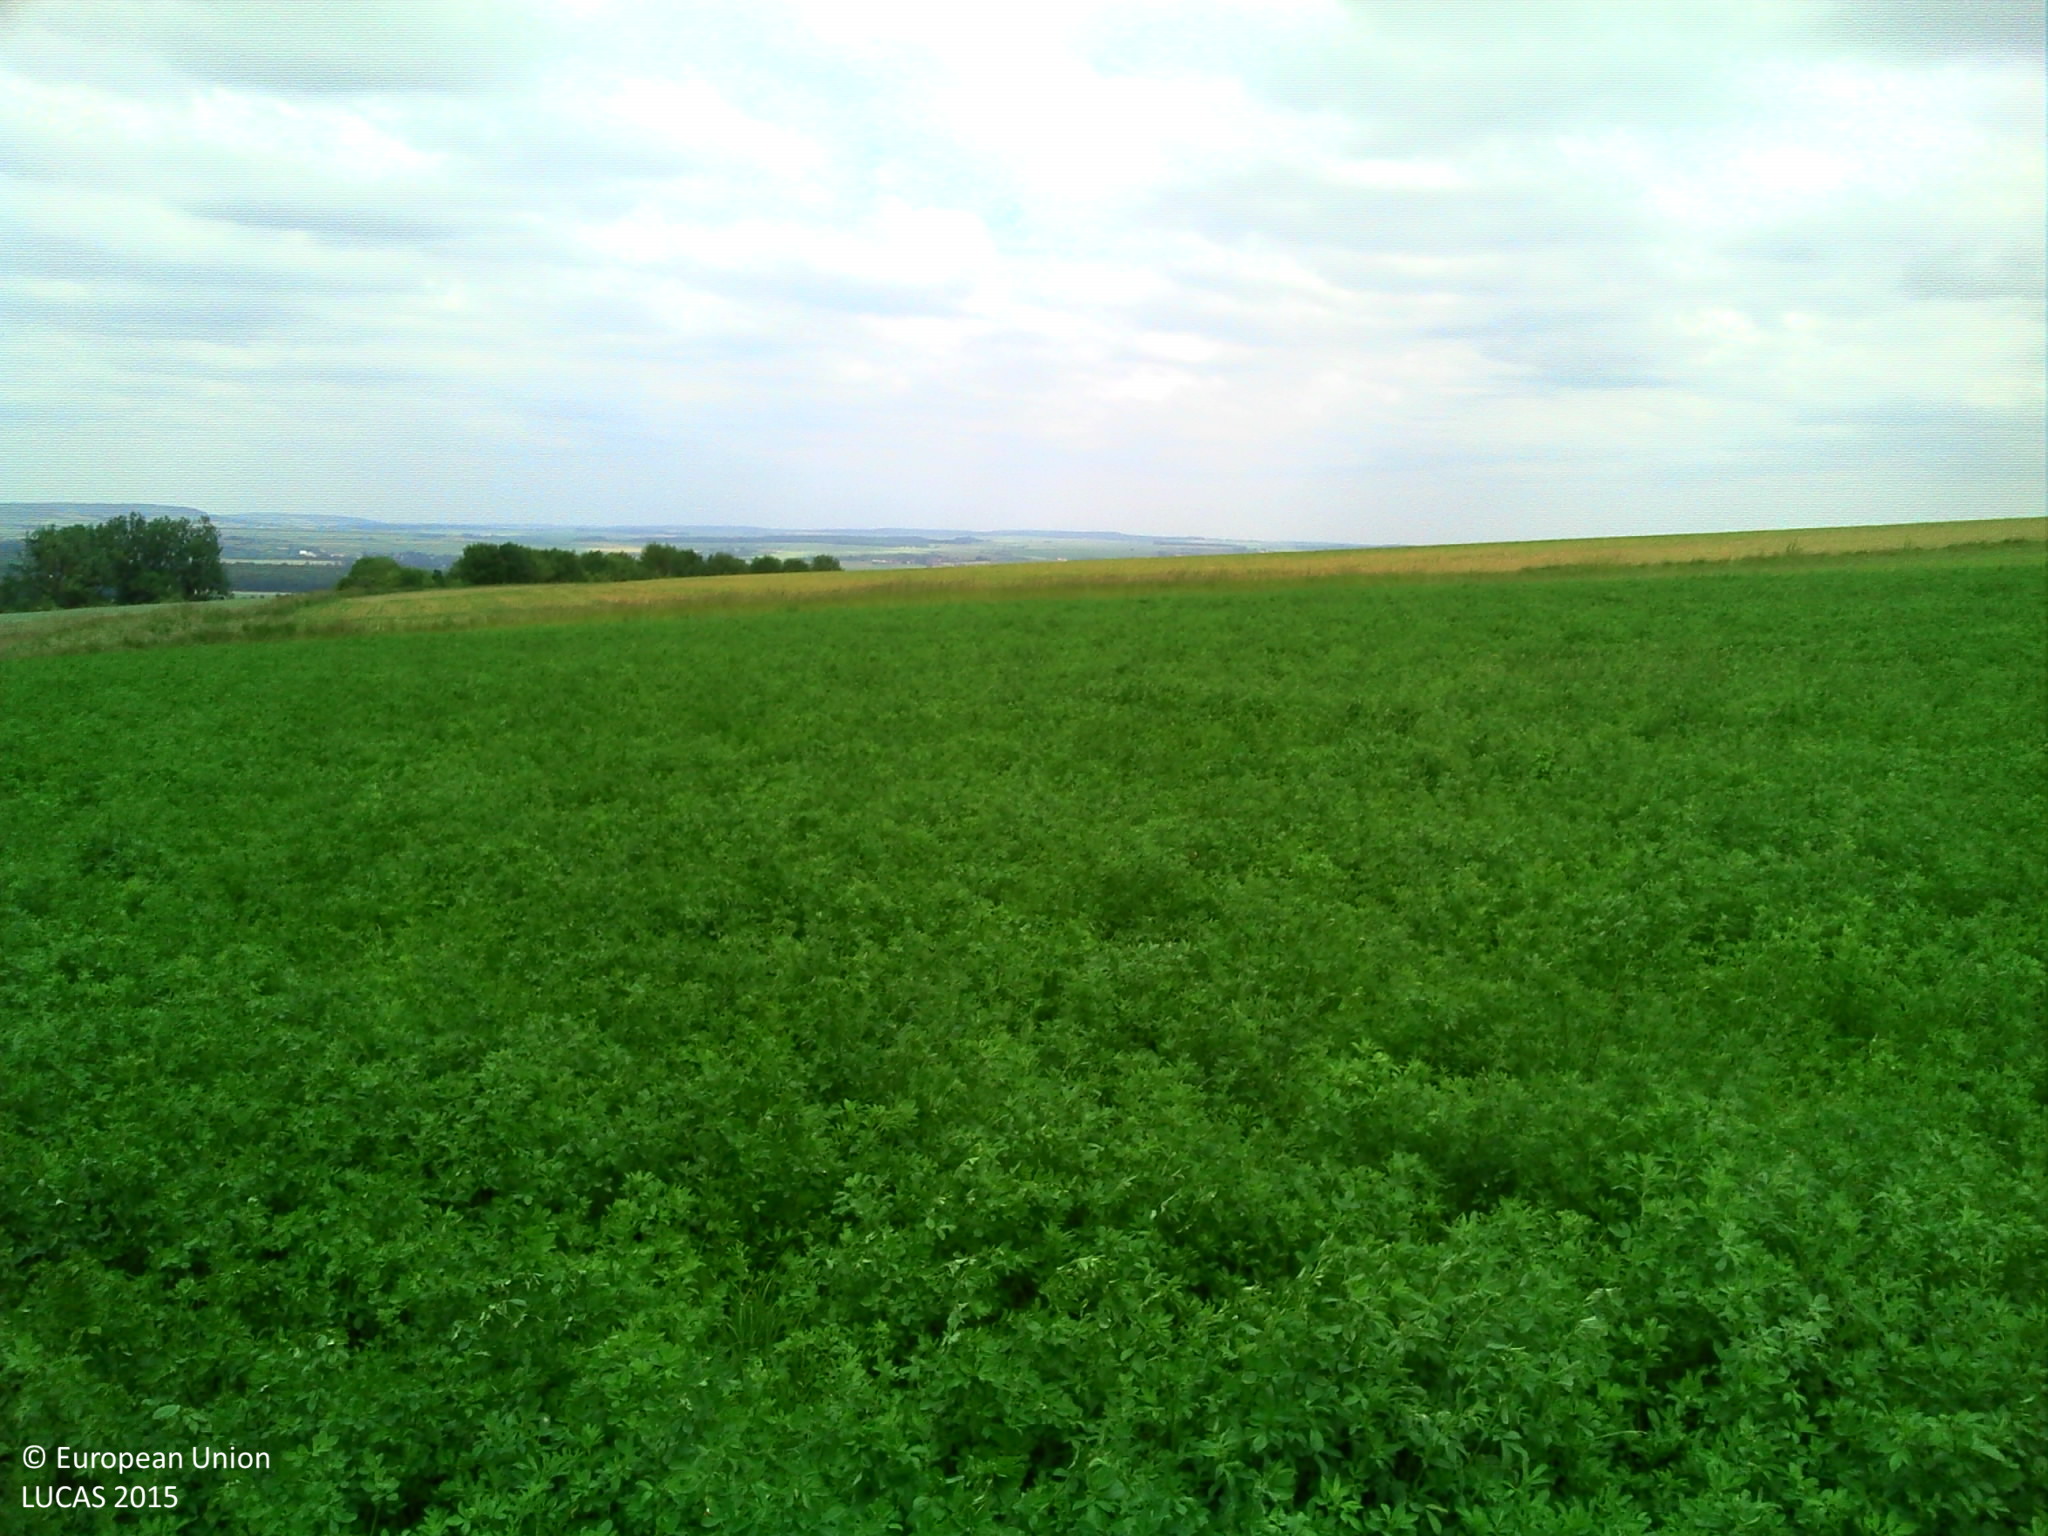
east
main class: Cropland
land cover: Lucerne
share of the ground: > 75 %
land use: Agriculture (excluding fallow land and kitchen gardens)
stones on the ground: 25 - 50 %
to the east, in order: Lucerne; Grassland without tree/shrub cover; Tracks; Grass margins; Dry pulses
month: June
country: FR
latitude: 48.8434
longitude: 6.2255
